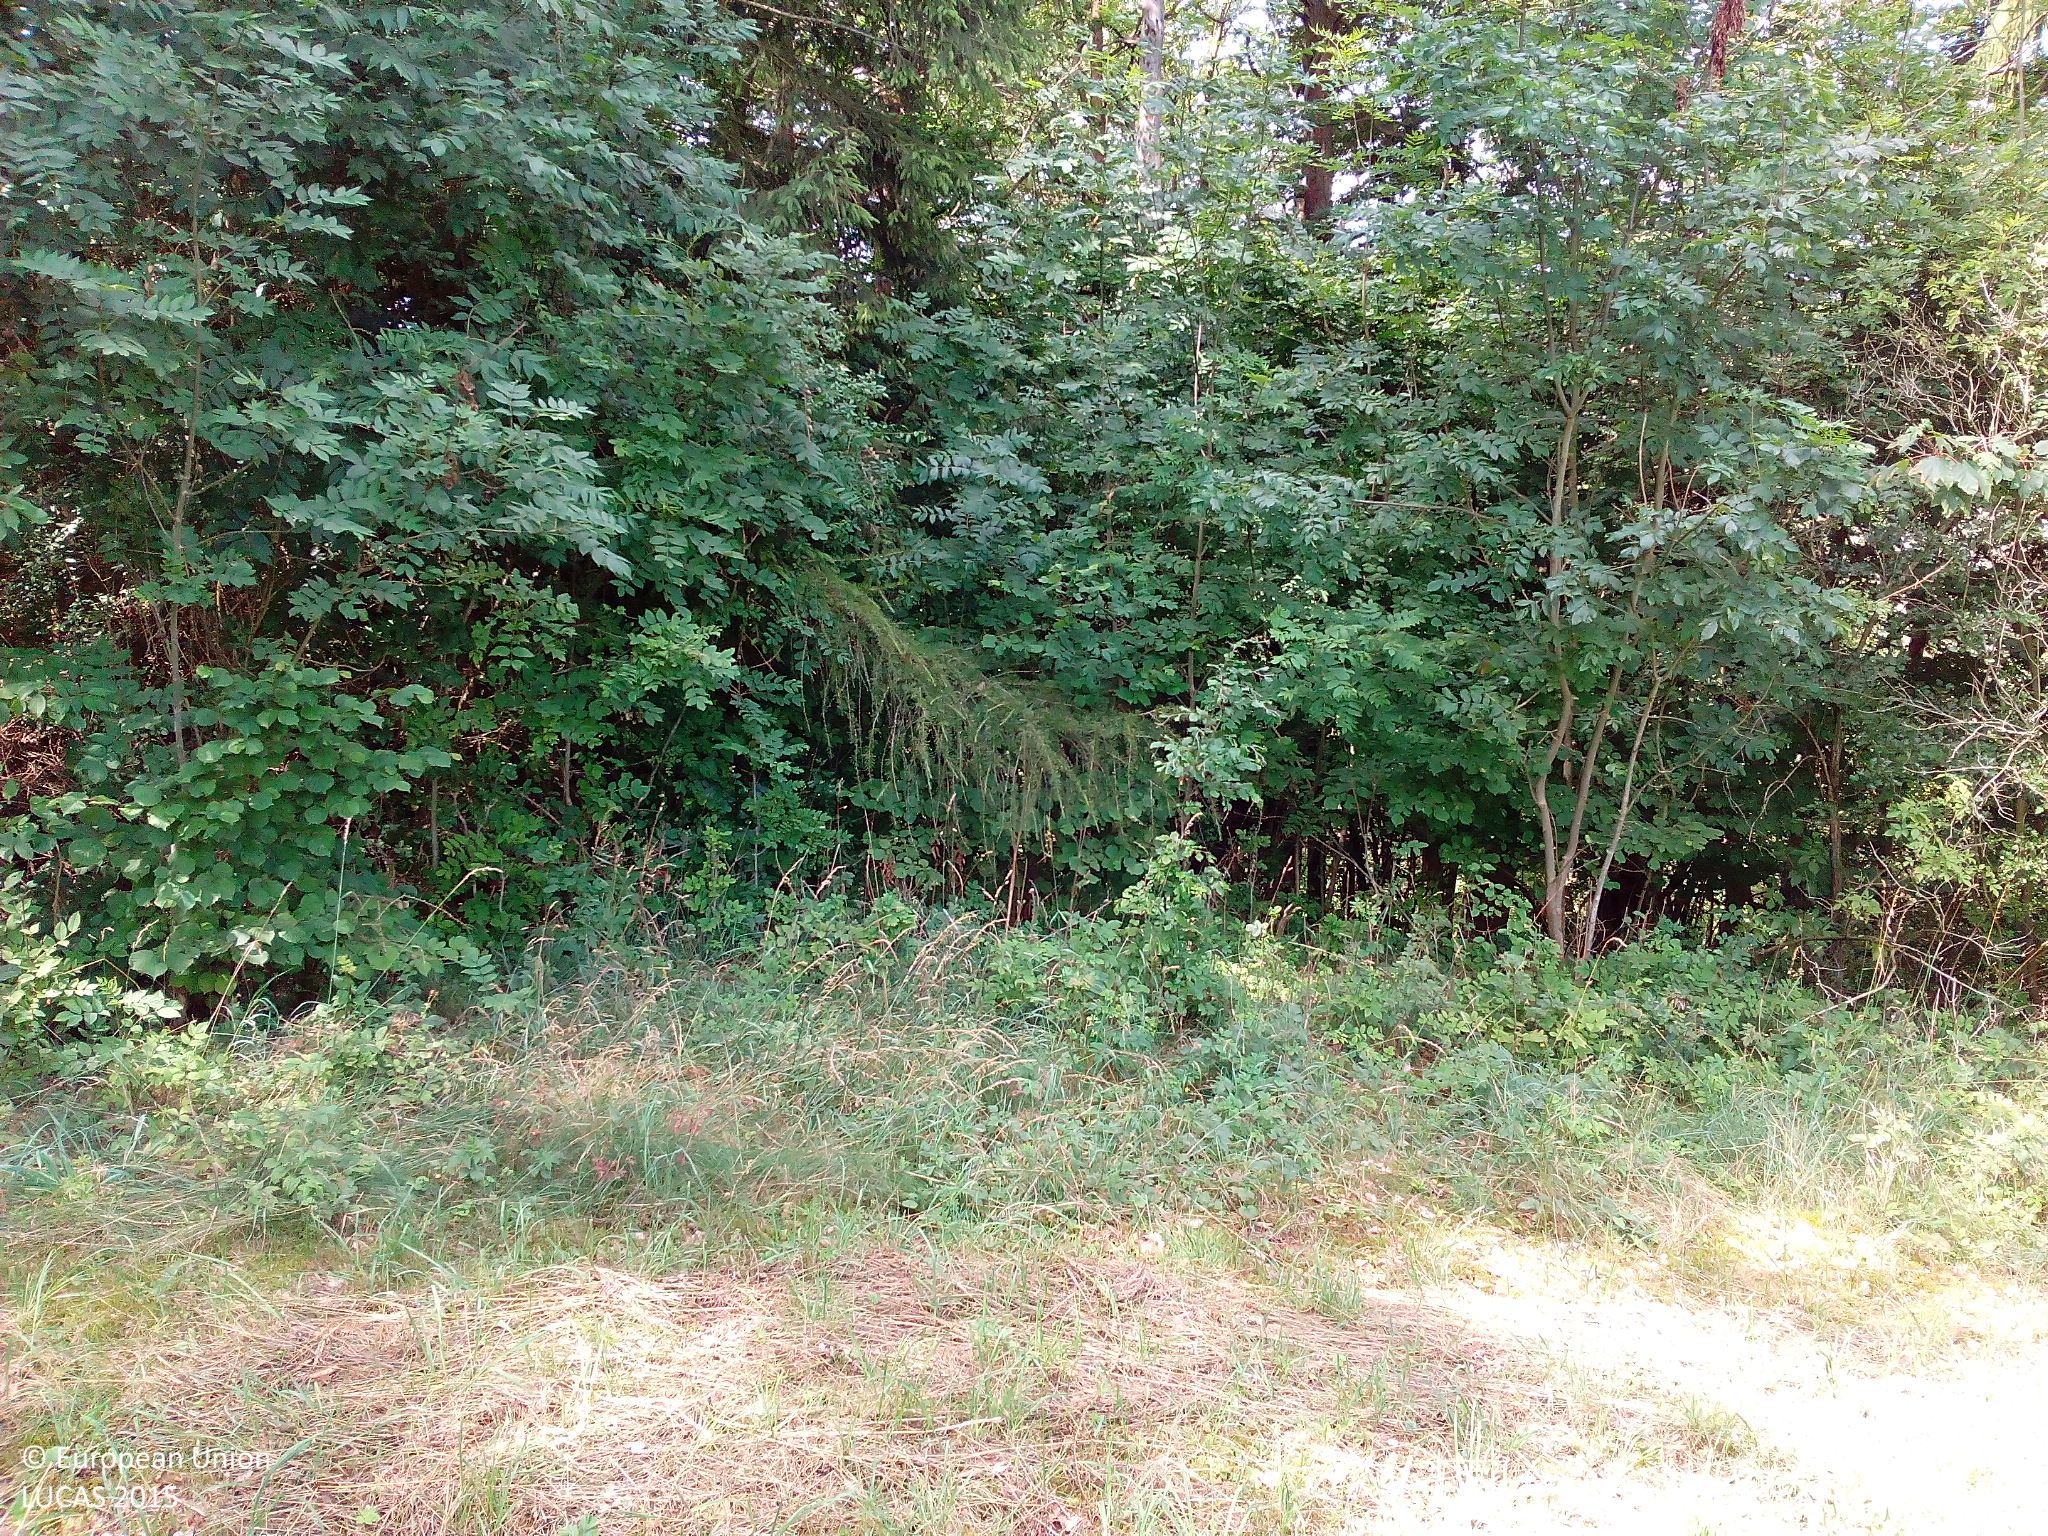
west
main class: Grassland
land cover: Grassland without tree/shrub cover
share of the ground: > 75 %
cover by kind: herbaceous plants 100 %
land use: Agriculture (excluding fallow land and kitchen gardens)
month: July
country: DE
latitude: 50.6697
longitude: 9.9293
